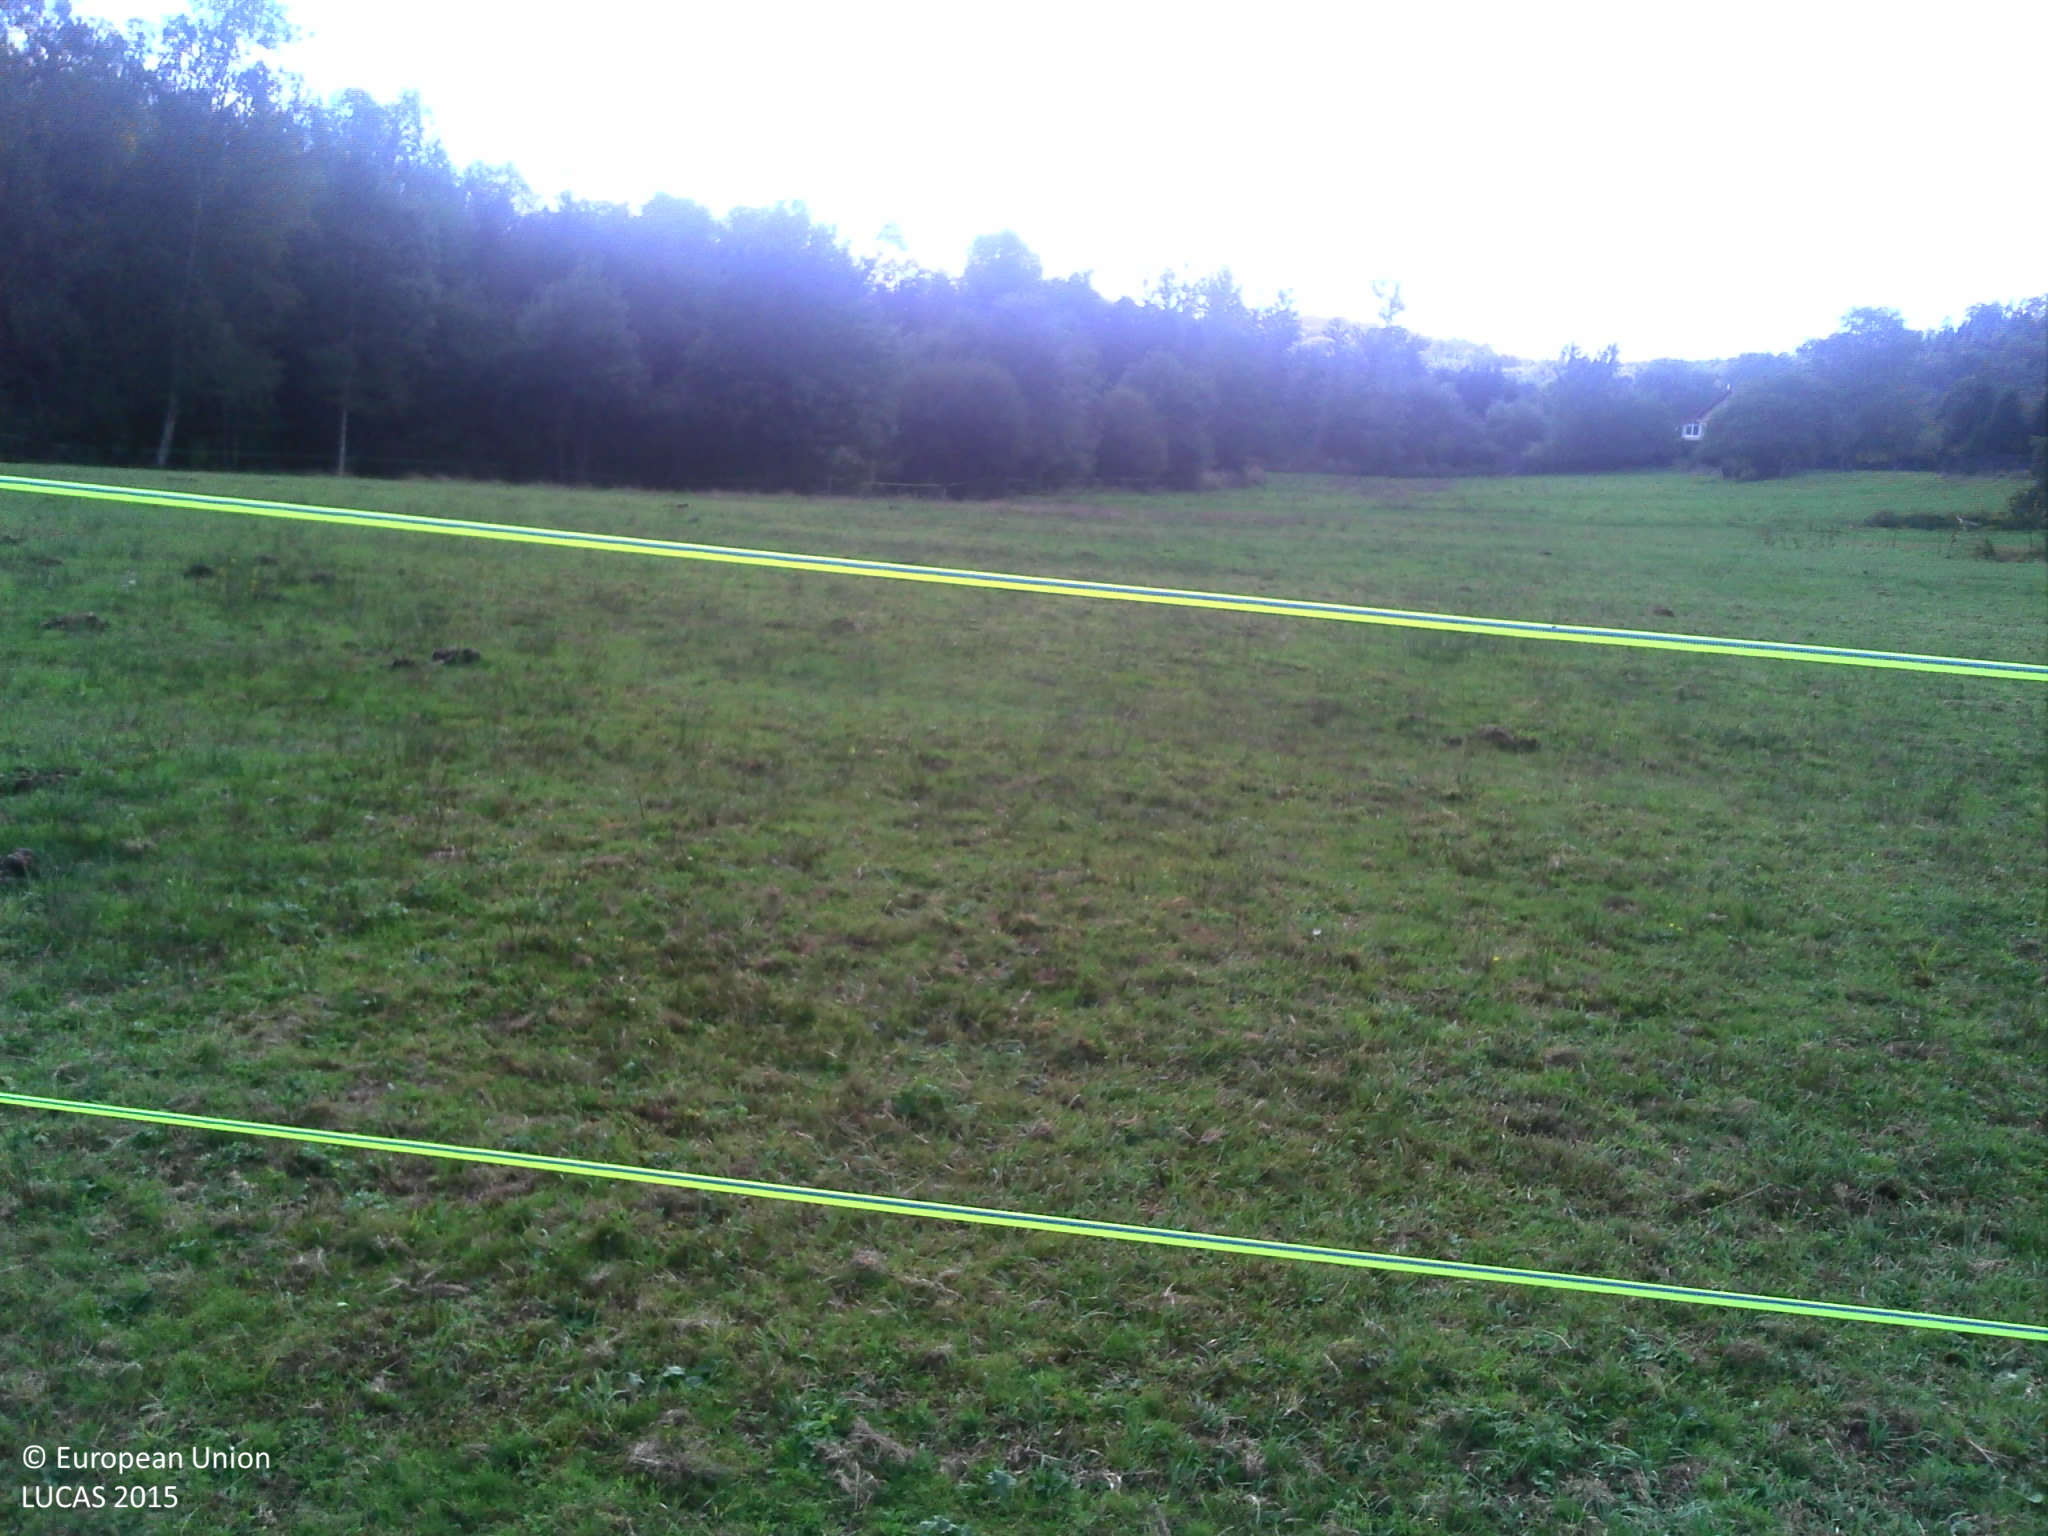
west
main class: Grassland
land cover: Grassland without tree/shrub cover
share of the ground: > 75 %
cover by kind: herbaceous plants 95 %, consolidated bare surface 5 %
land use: Agriculture (excluding fallow land and kitchen gardens)
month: September
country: FR
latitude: 48.4112
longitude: 6.7988
